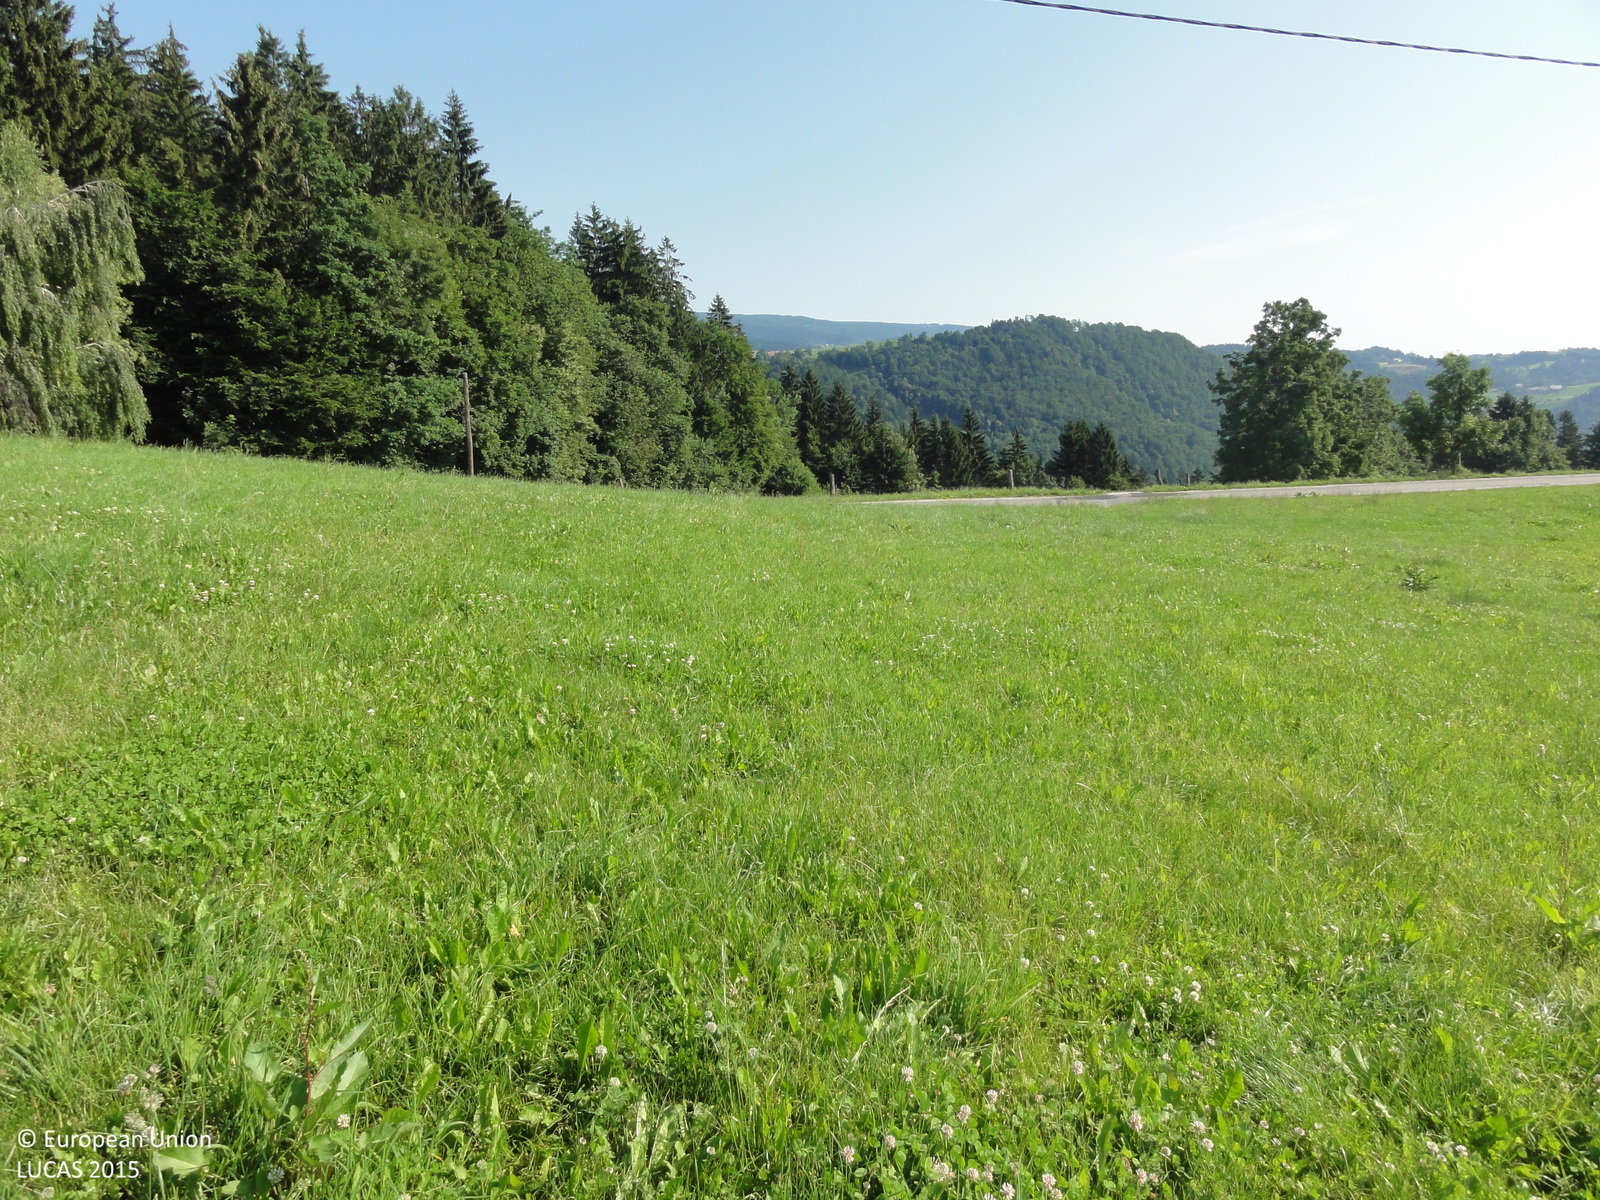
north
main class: Grassland
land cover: Grassland without tree/shrub cover
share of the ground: > 75 %
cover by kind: herbaceous plants 100 %
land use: Agriculture (excluding fallow land and kitchen gardens)
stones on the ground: < 10 %
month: July
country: SI
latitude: 46.4415
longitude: 15.5566
